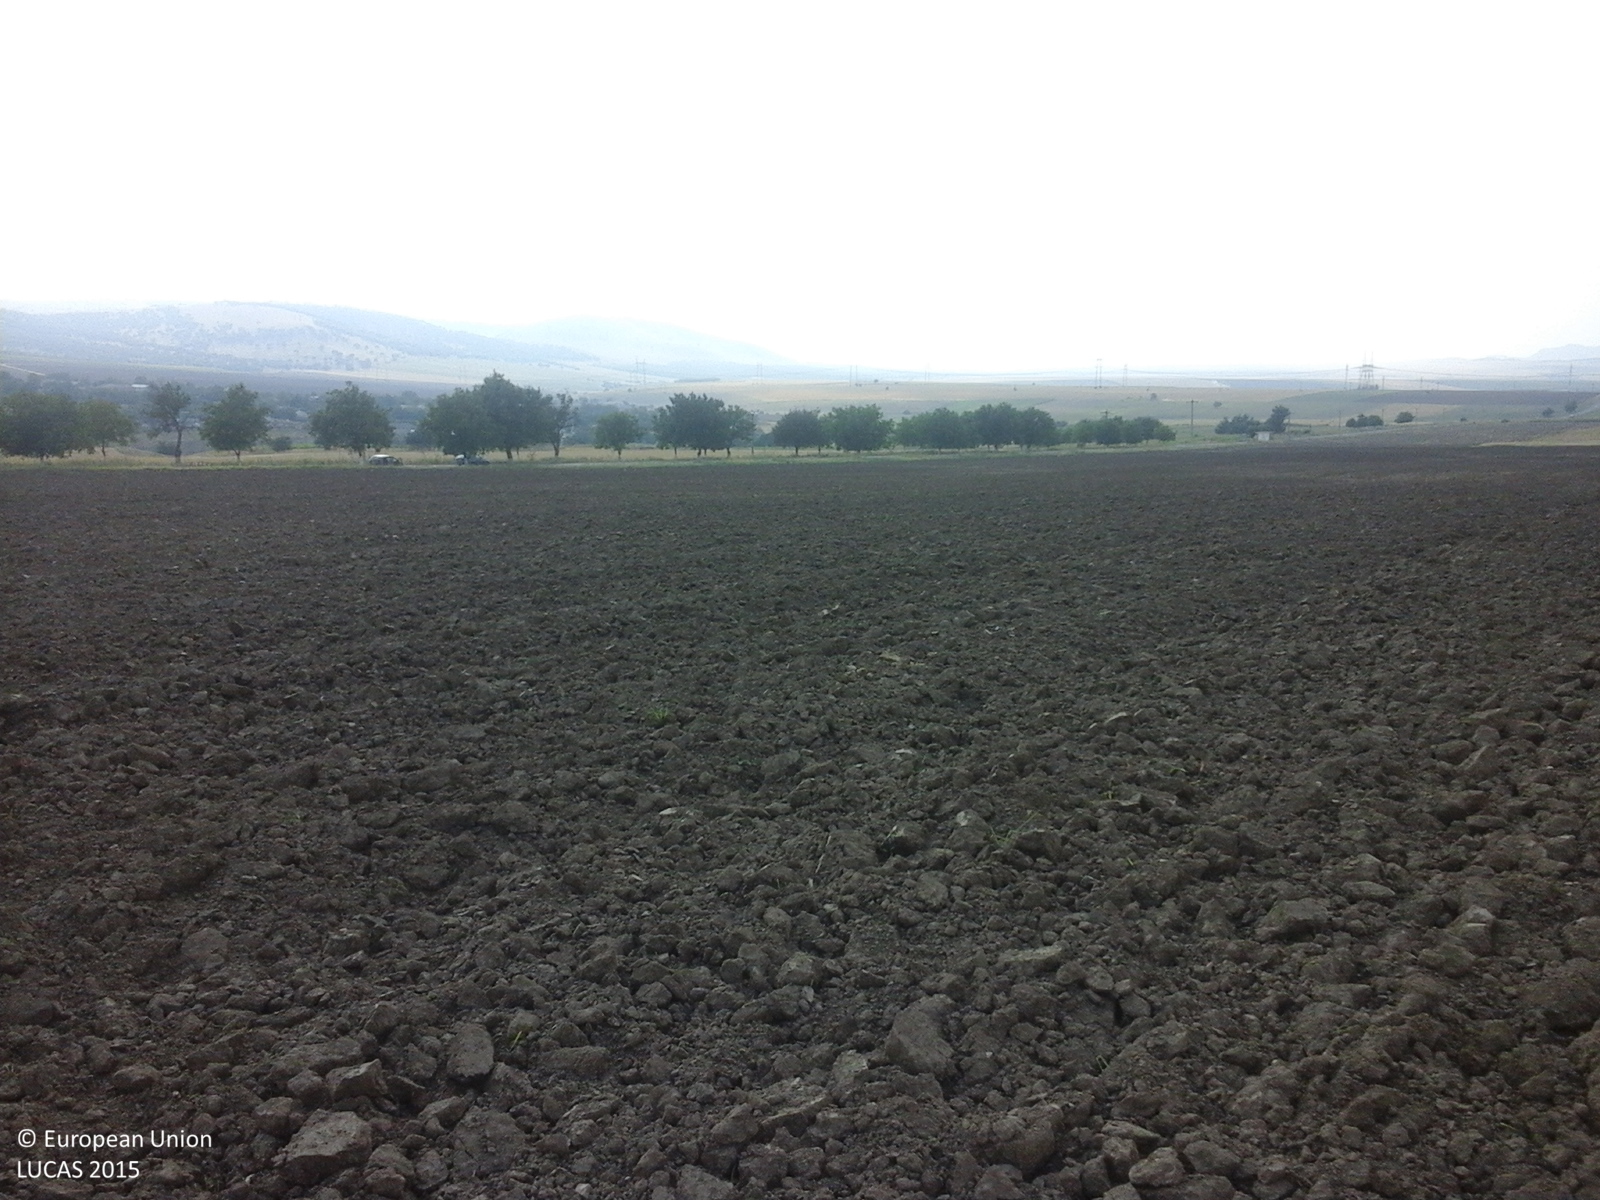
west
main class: Cropland
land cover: Common wheat
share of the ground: < 10 %
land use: Agriculture (excluding fallow land and kitchen gardens)
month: July
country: RO
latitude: 45.0164
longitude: 28.3854
